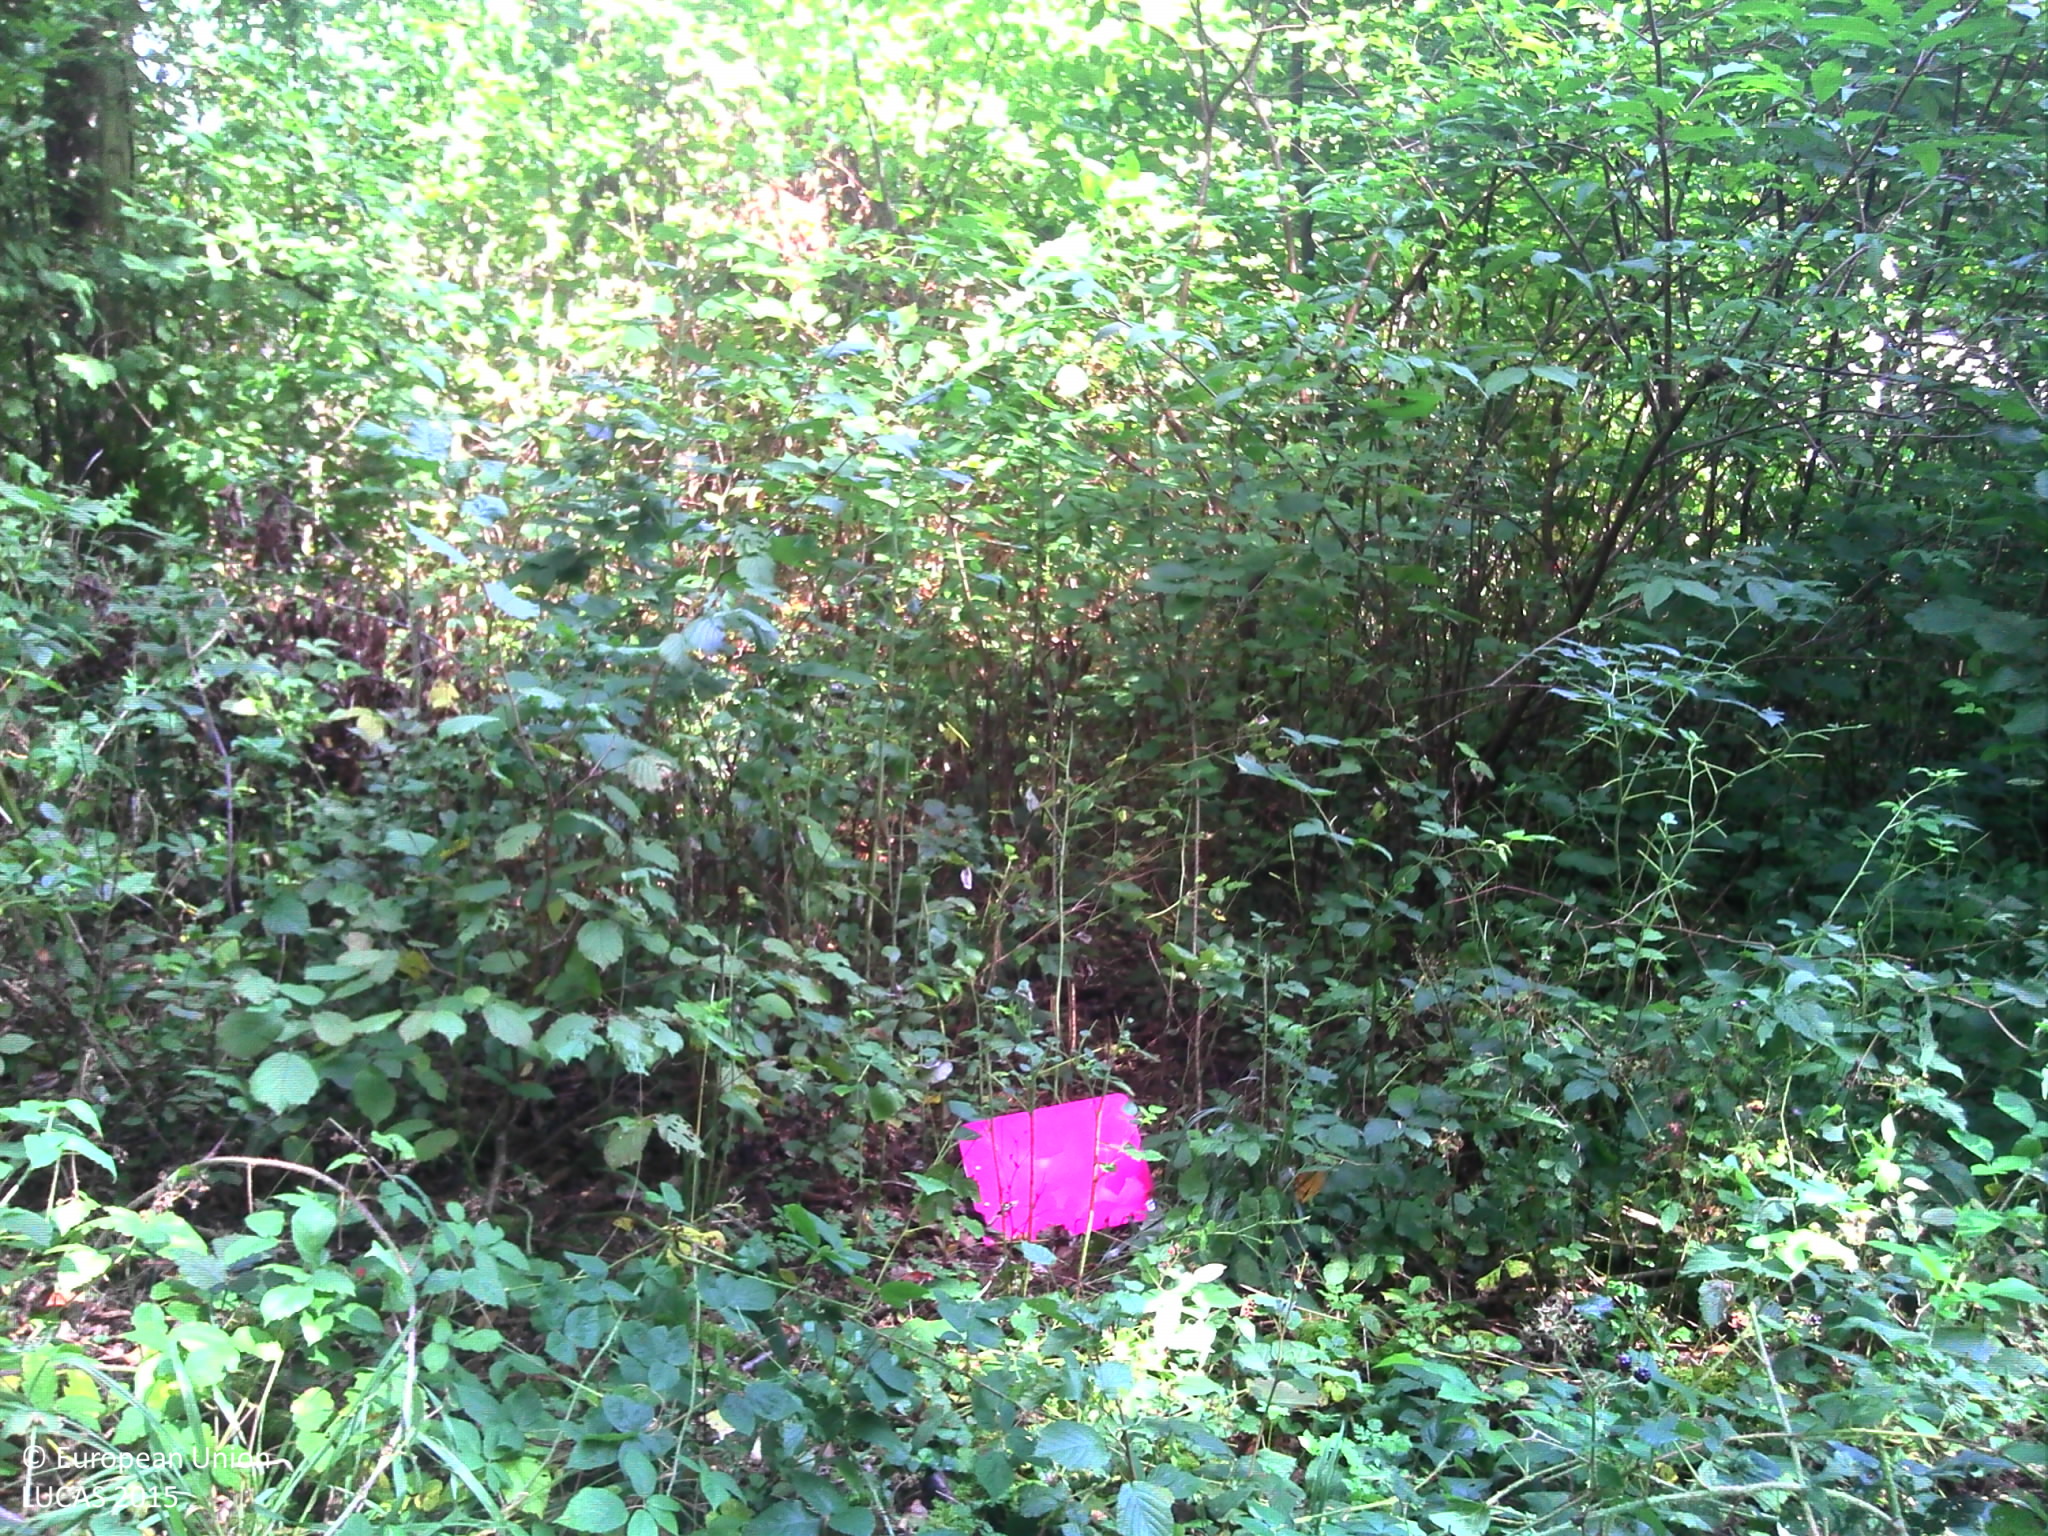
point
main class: Woodland
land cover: Broadleaved woodland
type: mesophytic deciduous forest
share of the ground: > 75 %
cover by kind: broadleaved forest trees 80 %, shrubs 20 %
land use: Forestry
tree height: > 5 m
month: August
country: FR
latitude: 47.6569
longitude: 6.8725
